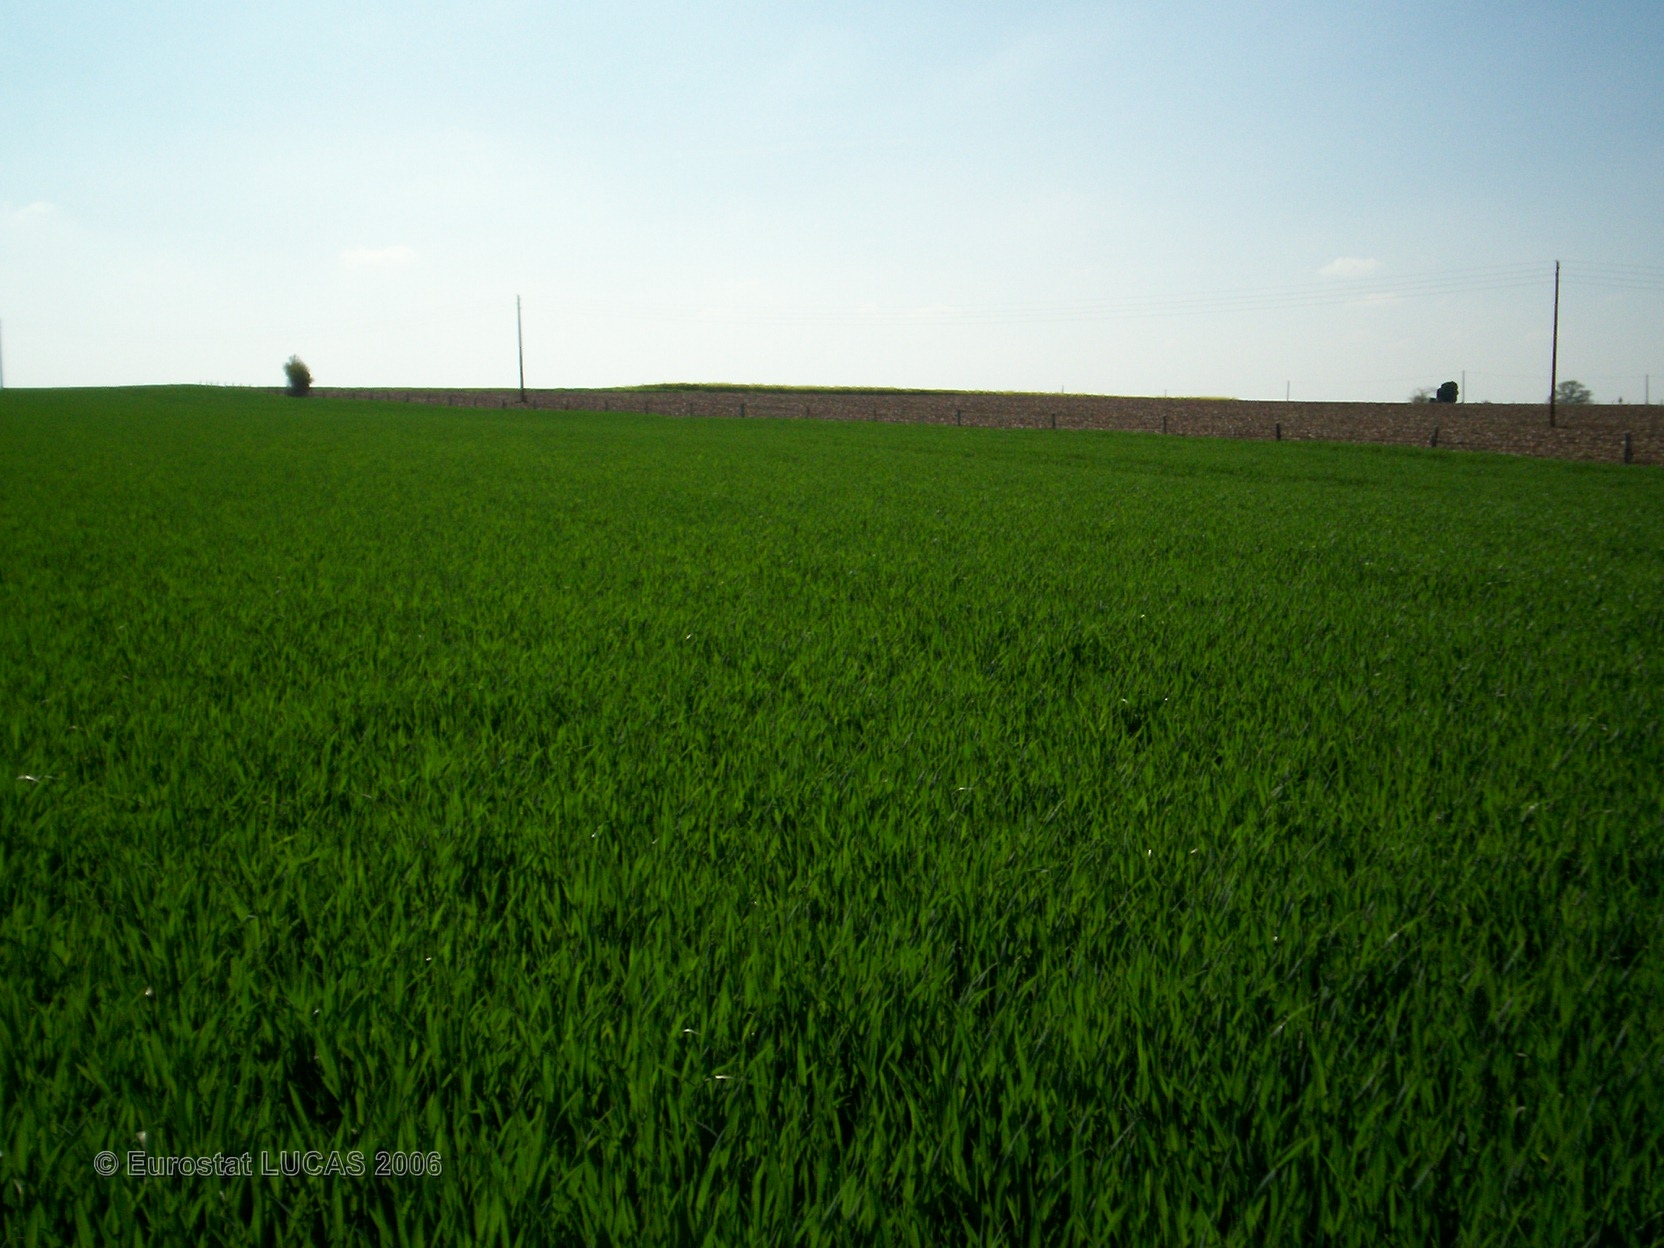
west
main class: Cropland
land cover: Common wheat
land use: Agriculture (excluding fallow land and kitchen gardens)
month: May
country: FR
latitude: 48.1457
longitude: -1.1565
